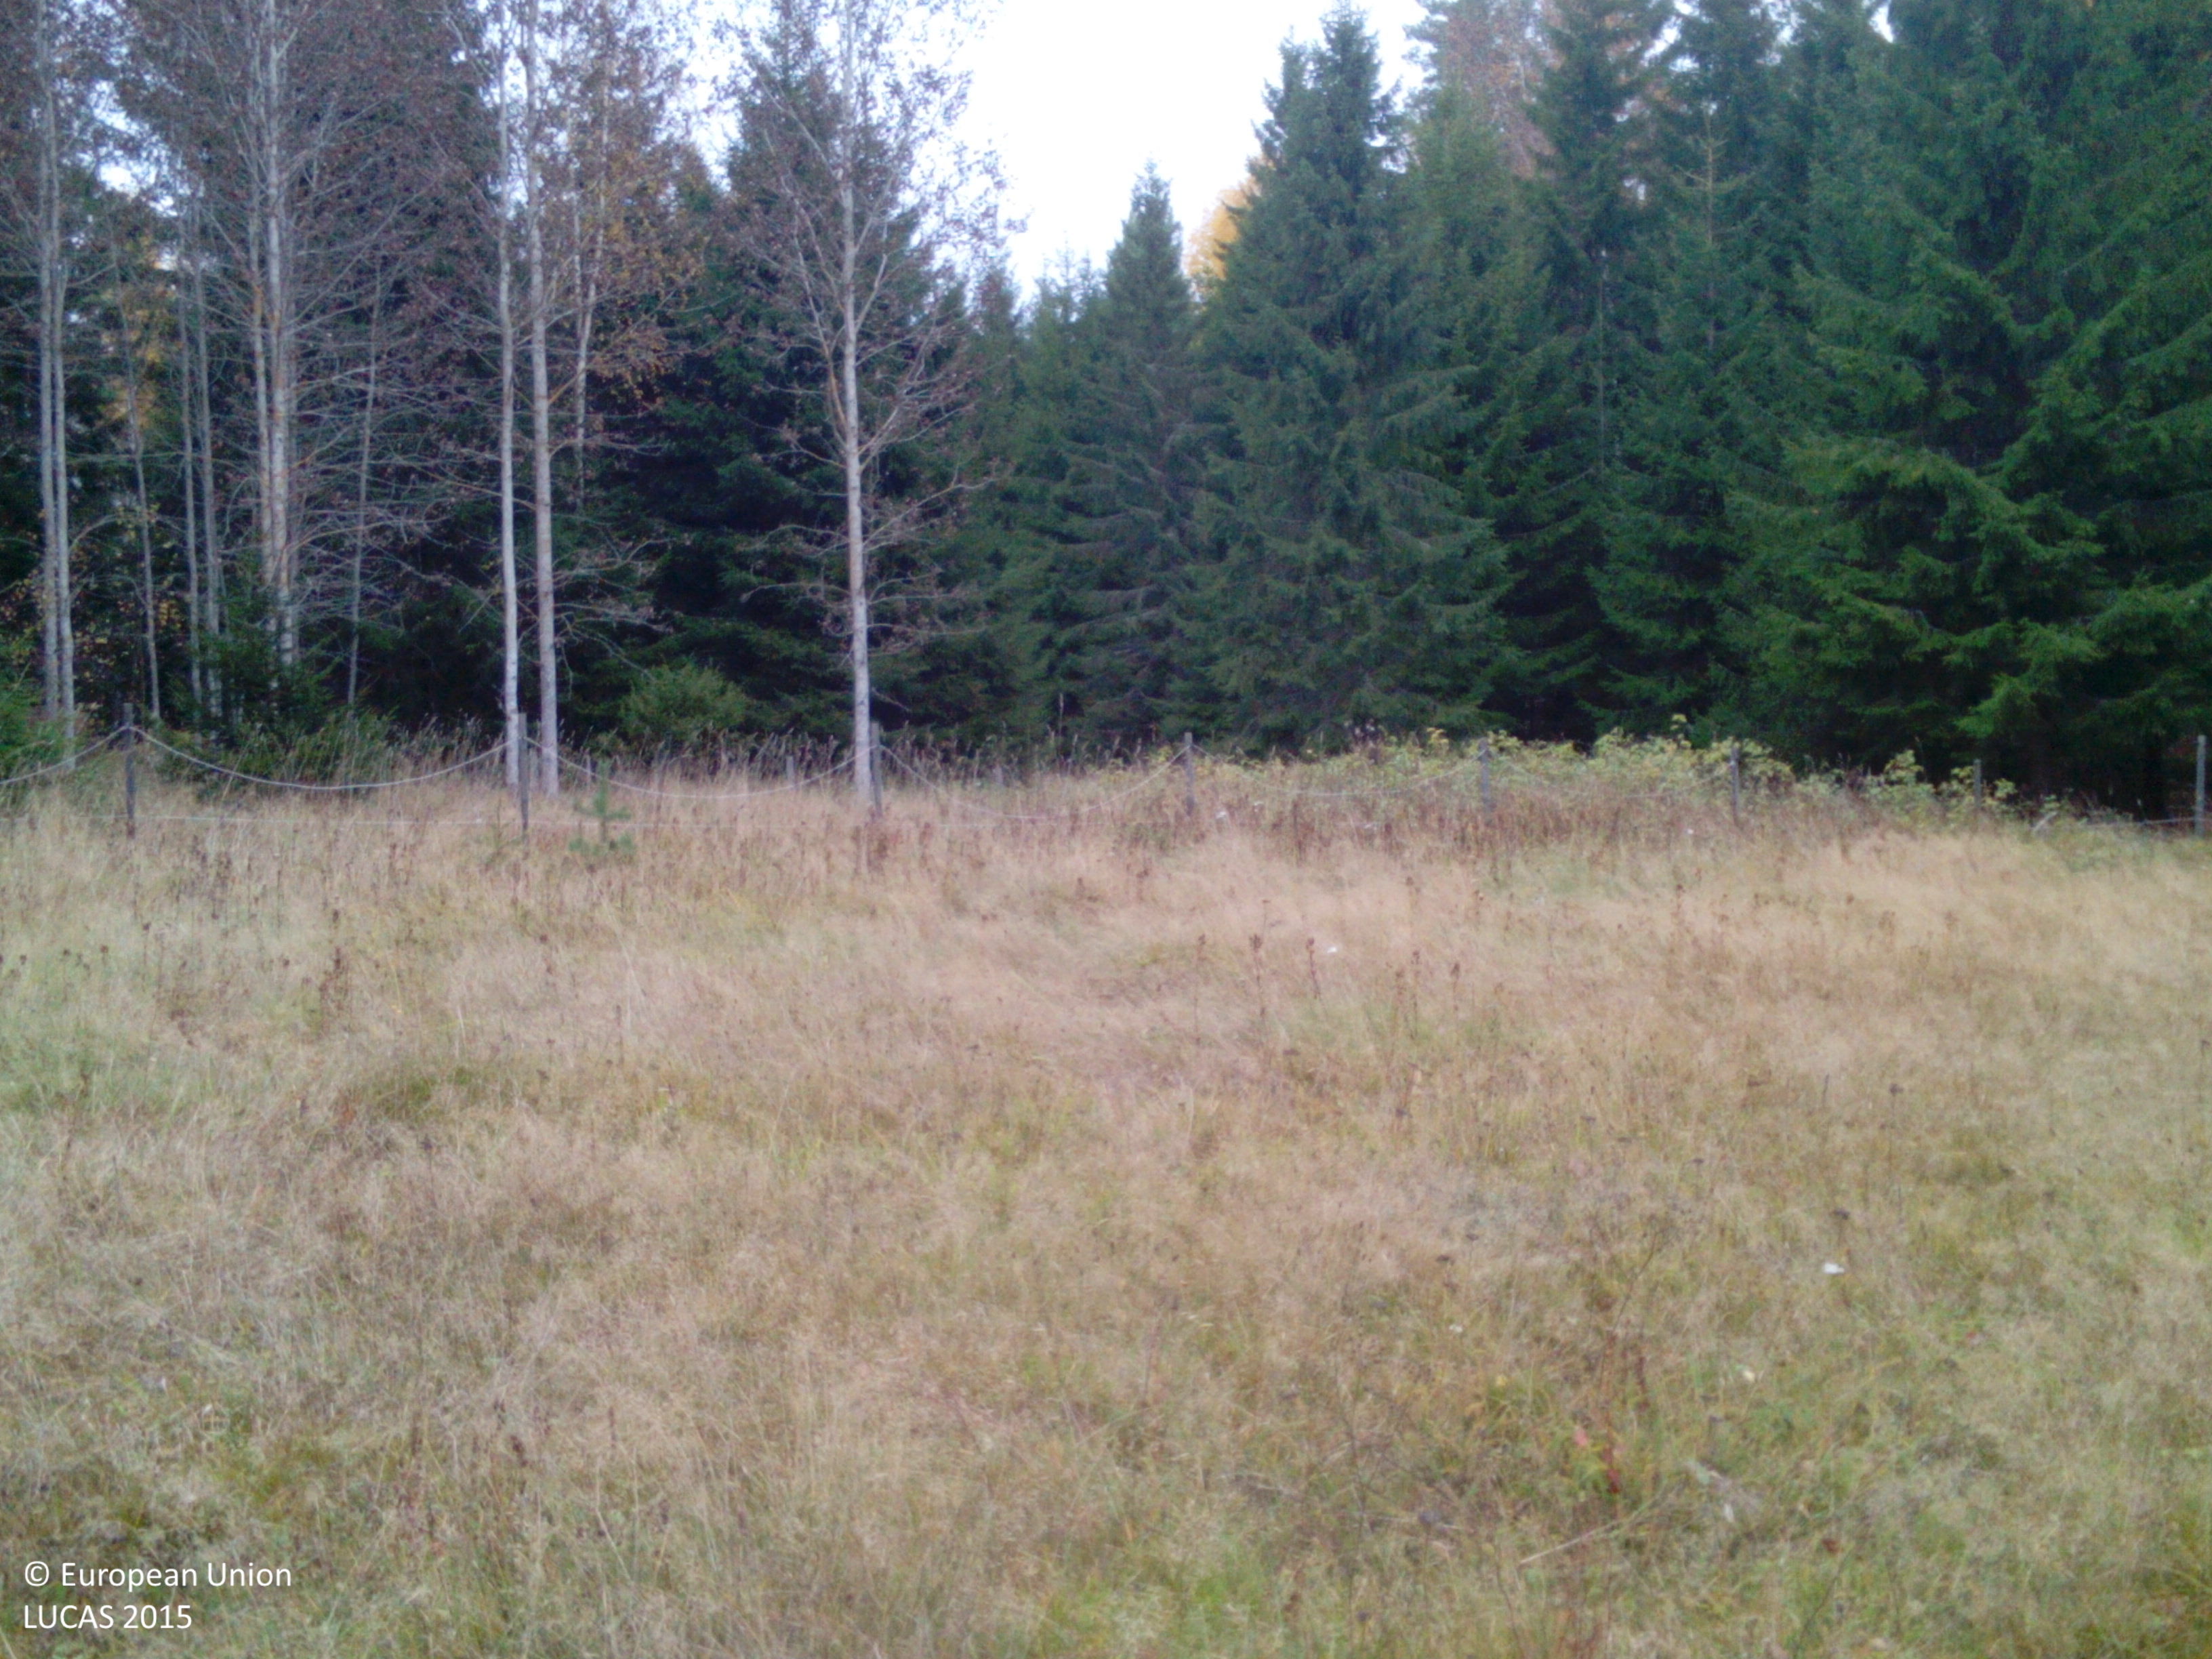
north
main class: Grassland
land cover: Grassland without tree/shrub cover
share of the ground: > 75 %
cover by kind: herbaceous plants 100 %
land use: Agriculture (excluding fallow land and kitchen gardens)
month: October
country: SE
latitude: 59.2474
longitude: 16.2524
